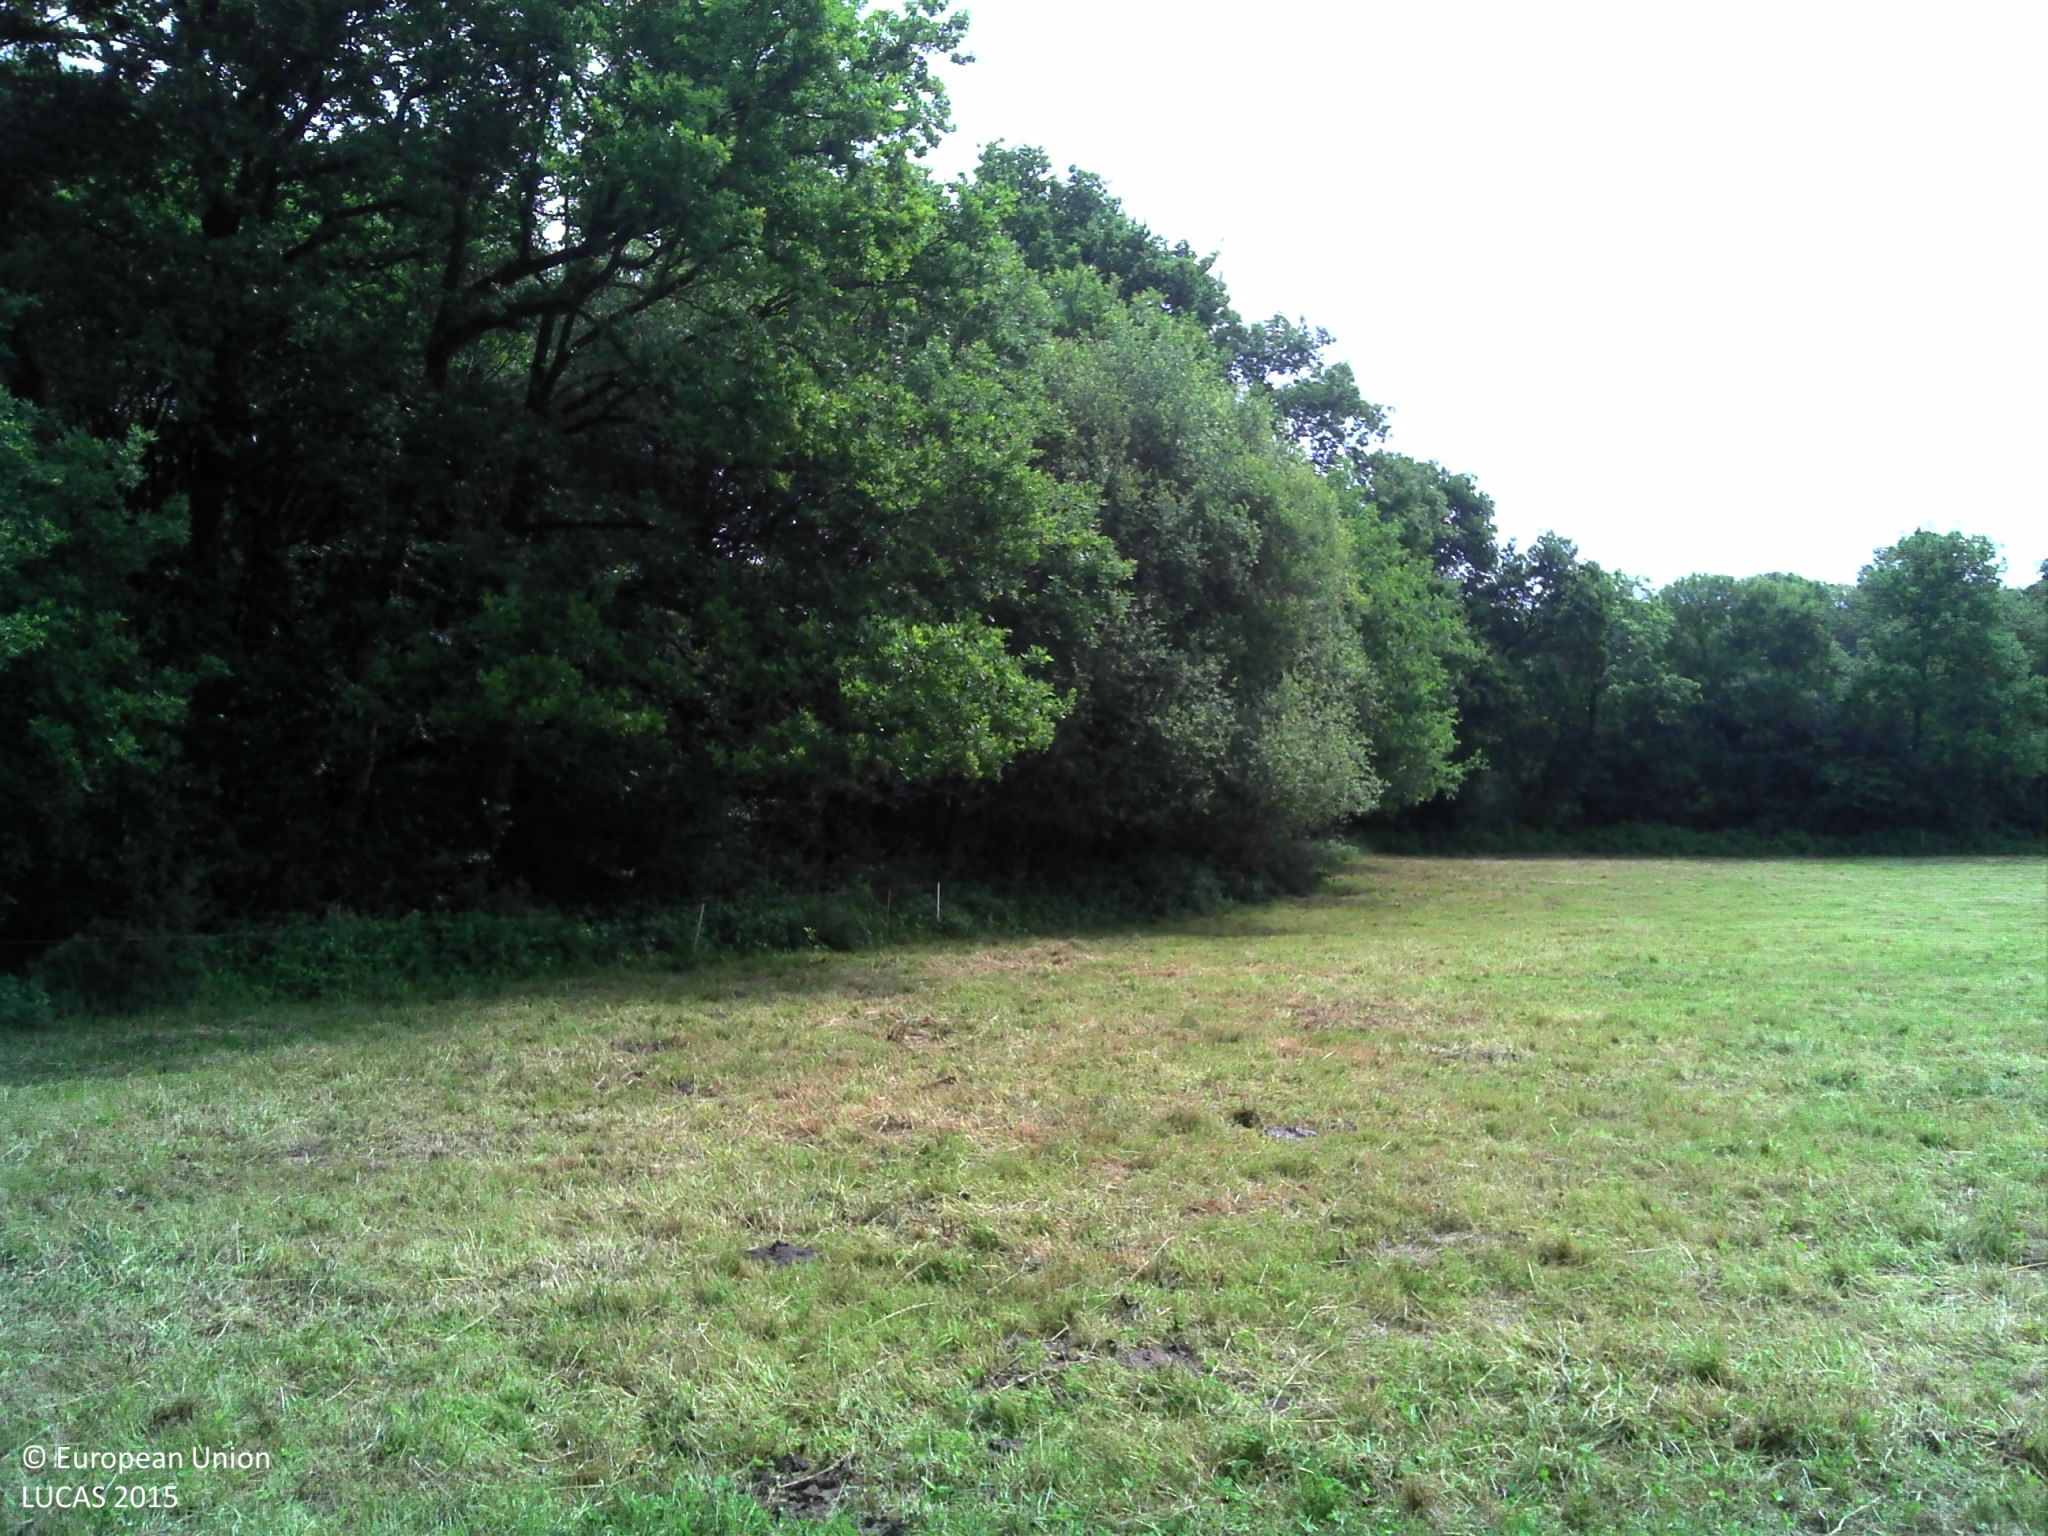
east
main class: Grassland
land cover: Grassland without tree/shrub cover
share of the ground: > 75 %
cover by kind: herbaceous plants 100 %
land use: Agriculture (excluding fallow land and kitchen gardens)
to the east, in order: Grassland without tree/shrub cover; Broadleaved woodland; Grassland without tree/shrub cover
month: June
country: FR
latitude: 48.1503
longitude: -2.1387
